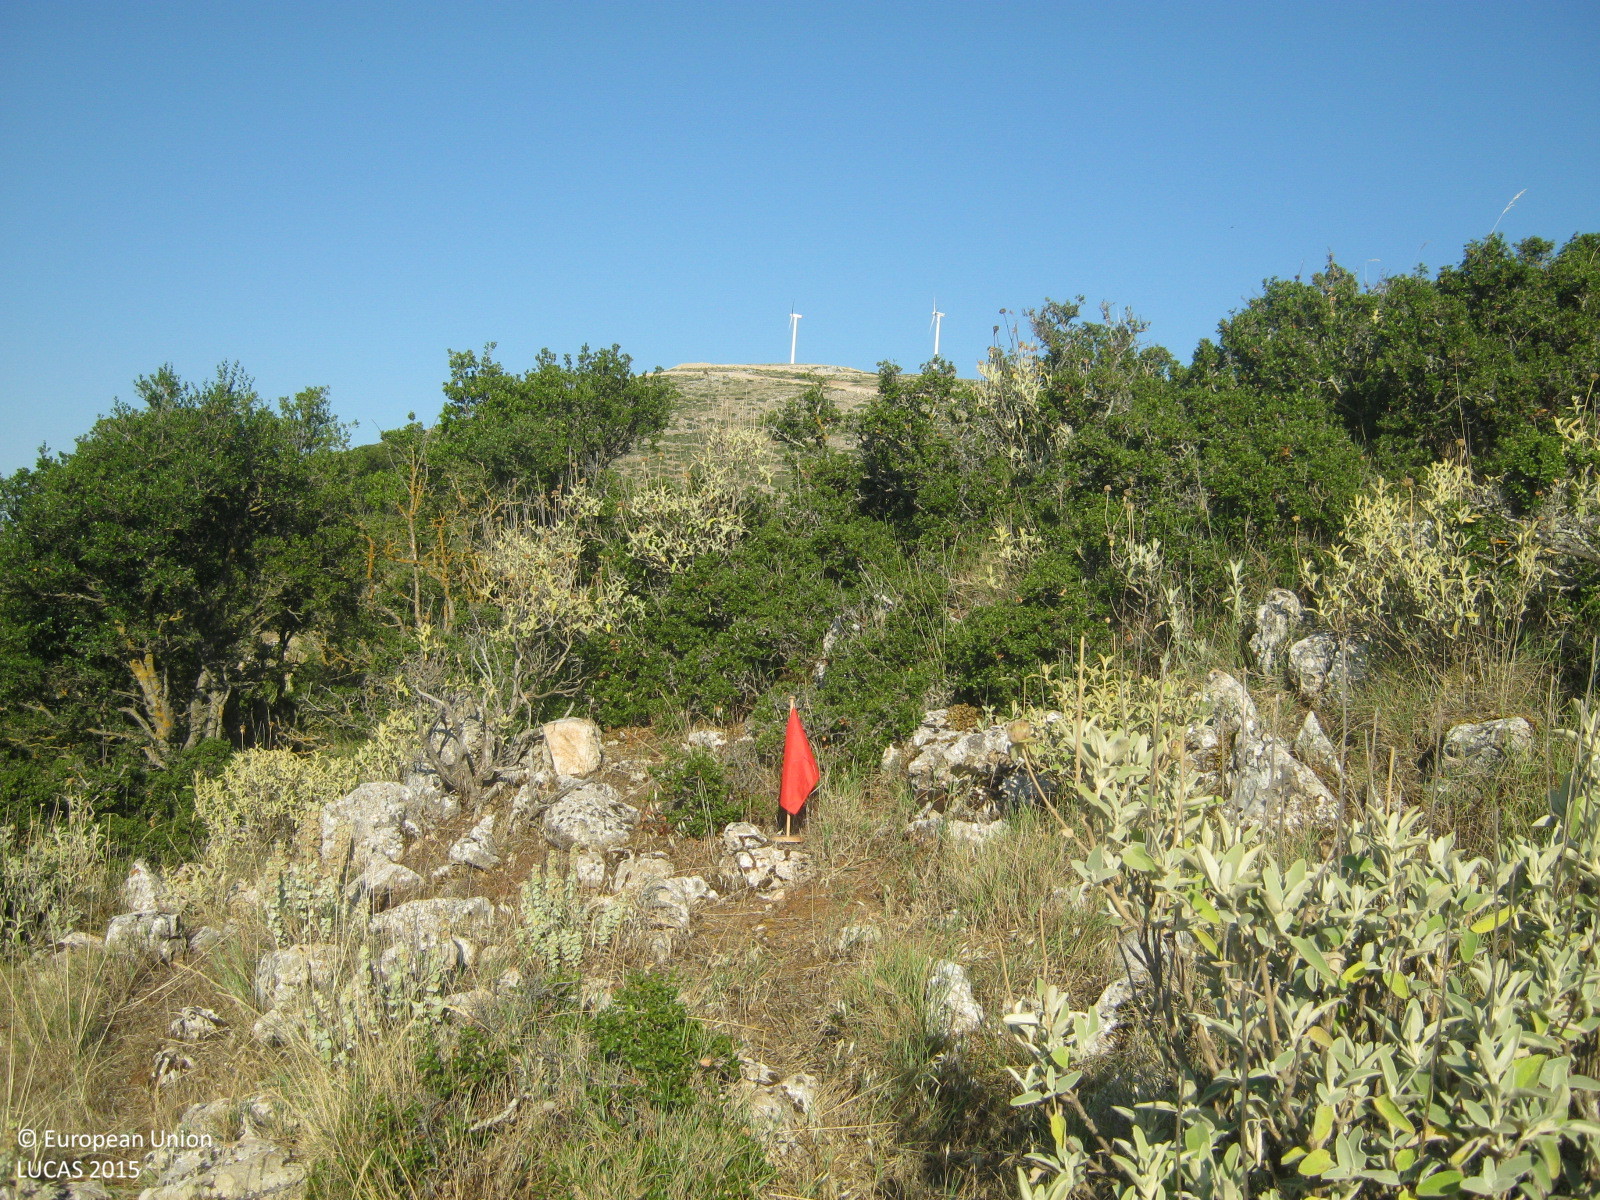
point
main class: Shrubland
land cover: Shrubland without tree cover
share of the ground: > 75 %
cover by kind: shrubs 85 %, unconsolidated bare surface 10 %, herbaceous plants 5 %
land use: Agriculture (excluding fallow land and kitchen gardens)
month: July
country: GR
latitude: 37.7758
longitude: 22.8096
